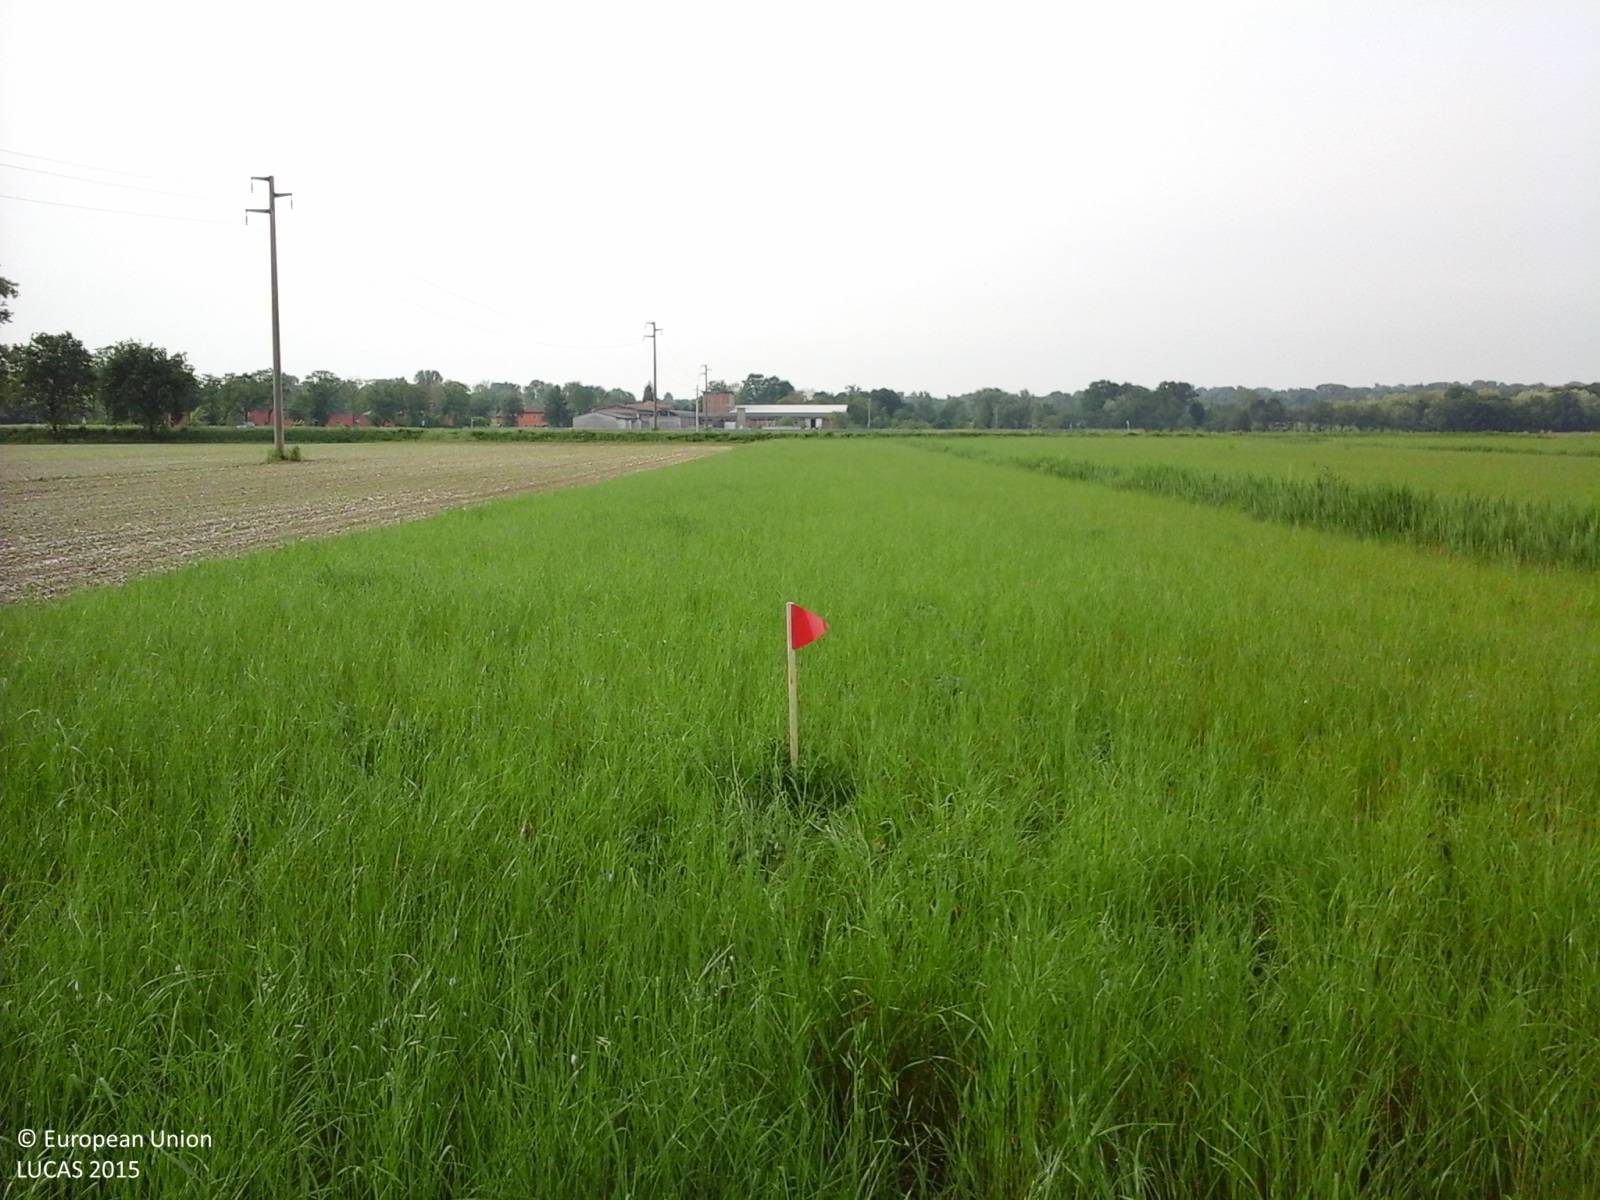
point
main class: Cropland
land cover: Temporary grasslands
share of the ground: > 75 %
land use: Agriculture (excluding fallow land and kitchen gardens)
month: May
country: IT
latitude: 46.1631
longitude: 13.0659
